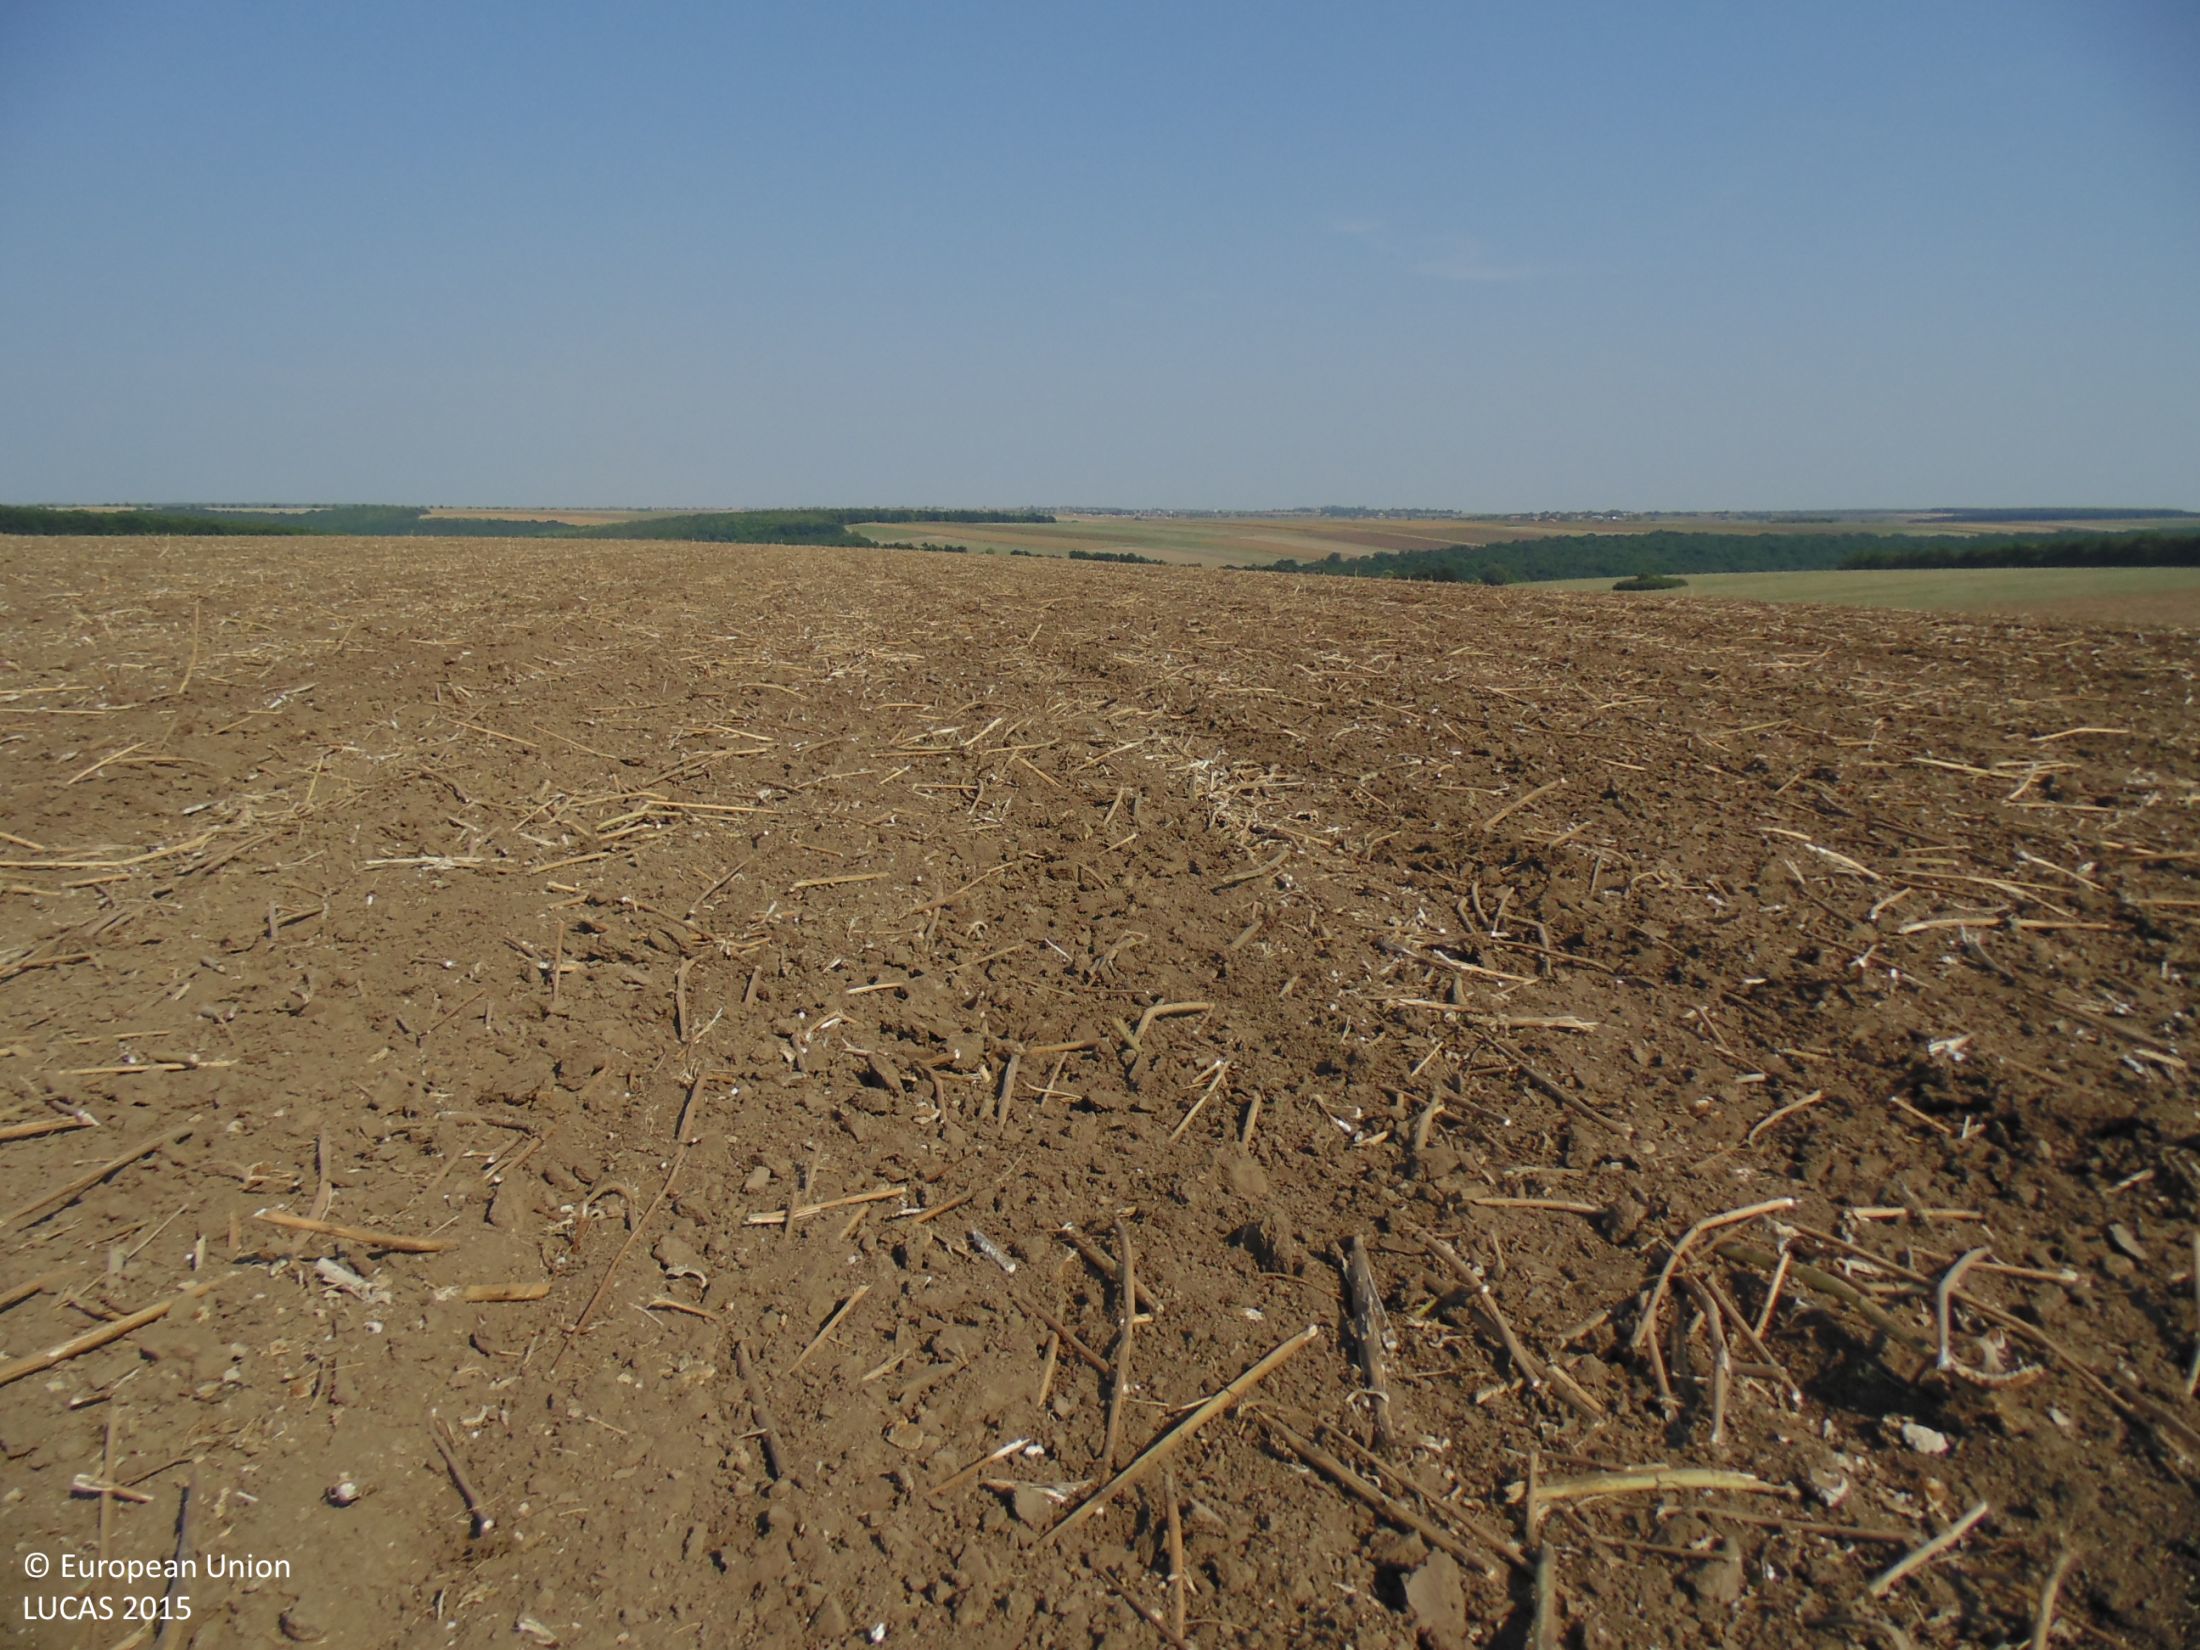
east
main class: Cropland
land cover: Sunflower
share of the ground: < 10 %
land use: Agriculture (excluding fallow land and kitchen gardens)
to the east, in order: Sunflower
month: September
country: BG
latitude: 43.8009
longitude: 26.8852
